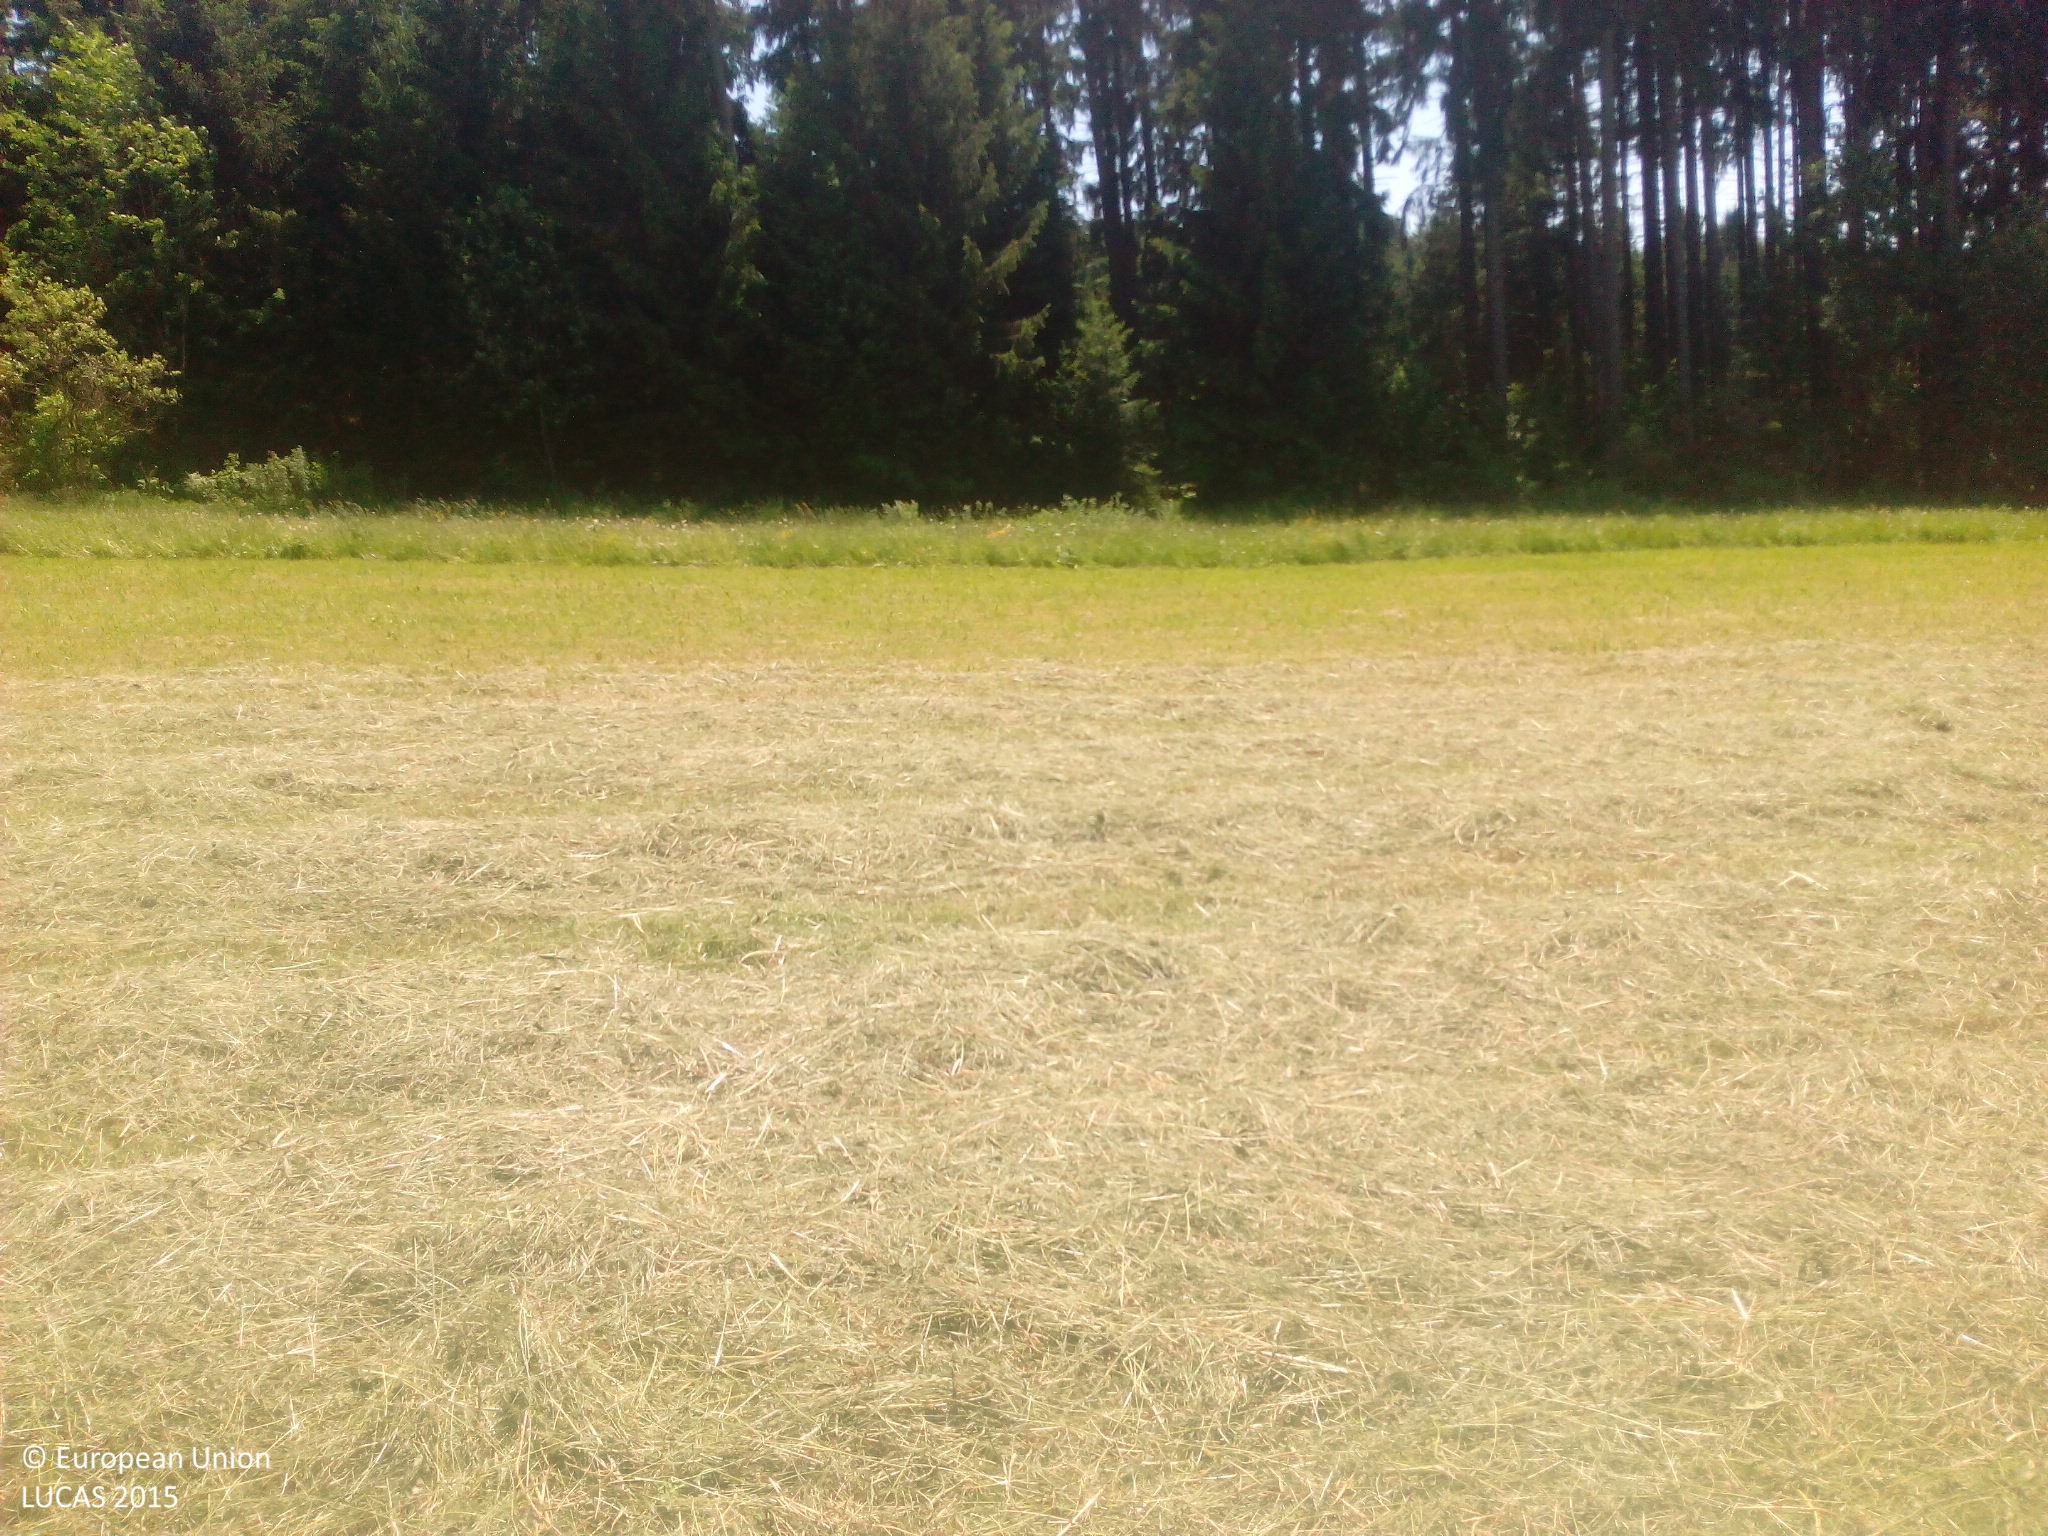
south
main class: Grassland
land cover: Grassland without tree/shrub cover
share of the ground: > 75 %
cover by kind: herbaceous plants 100 %
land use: Agriculture (excluding fallow land and kitchen gardens)
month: June
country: DE
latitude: 47.8624
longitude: 10.5209
